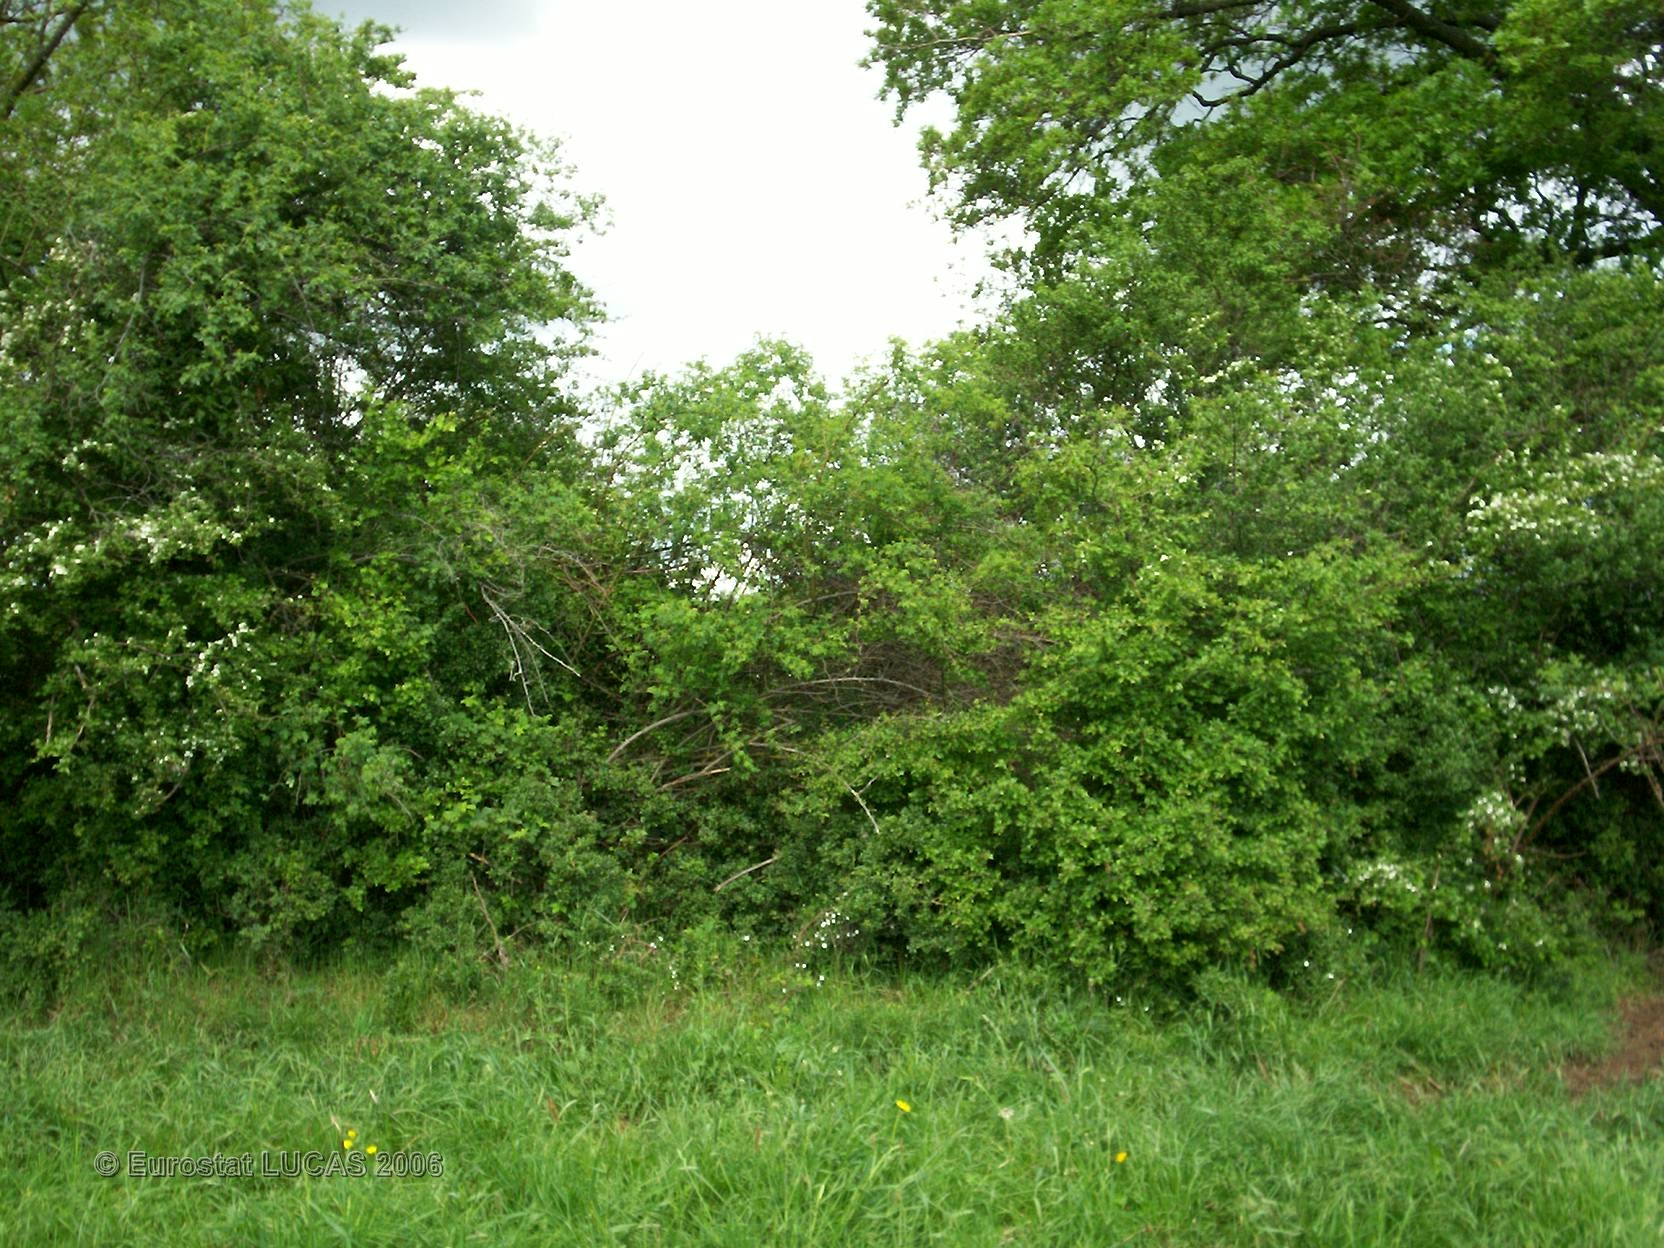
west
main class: Grassland
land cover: Grassland without tree/shrub cover
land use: Agriculture (excluding fallow land and kitchen gardens)
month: May
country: FR
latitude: 45.9539
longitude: 4.1058
